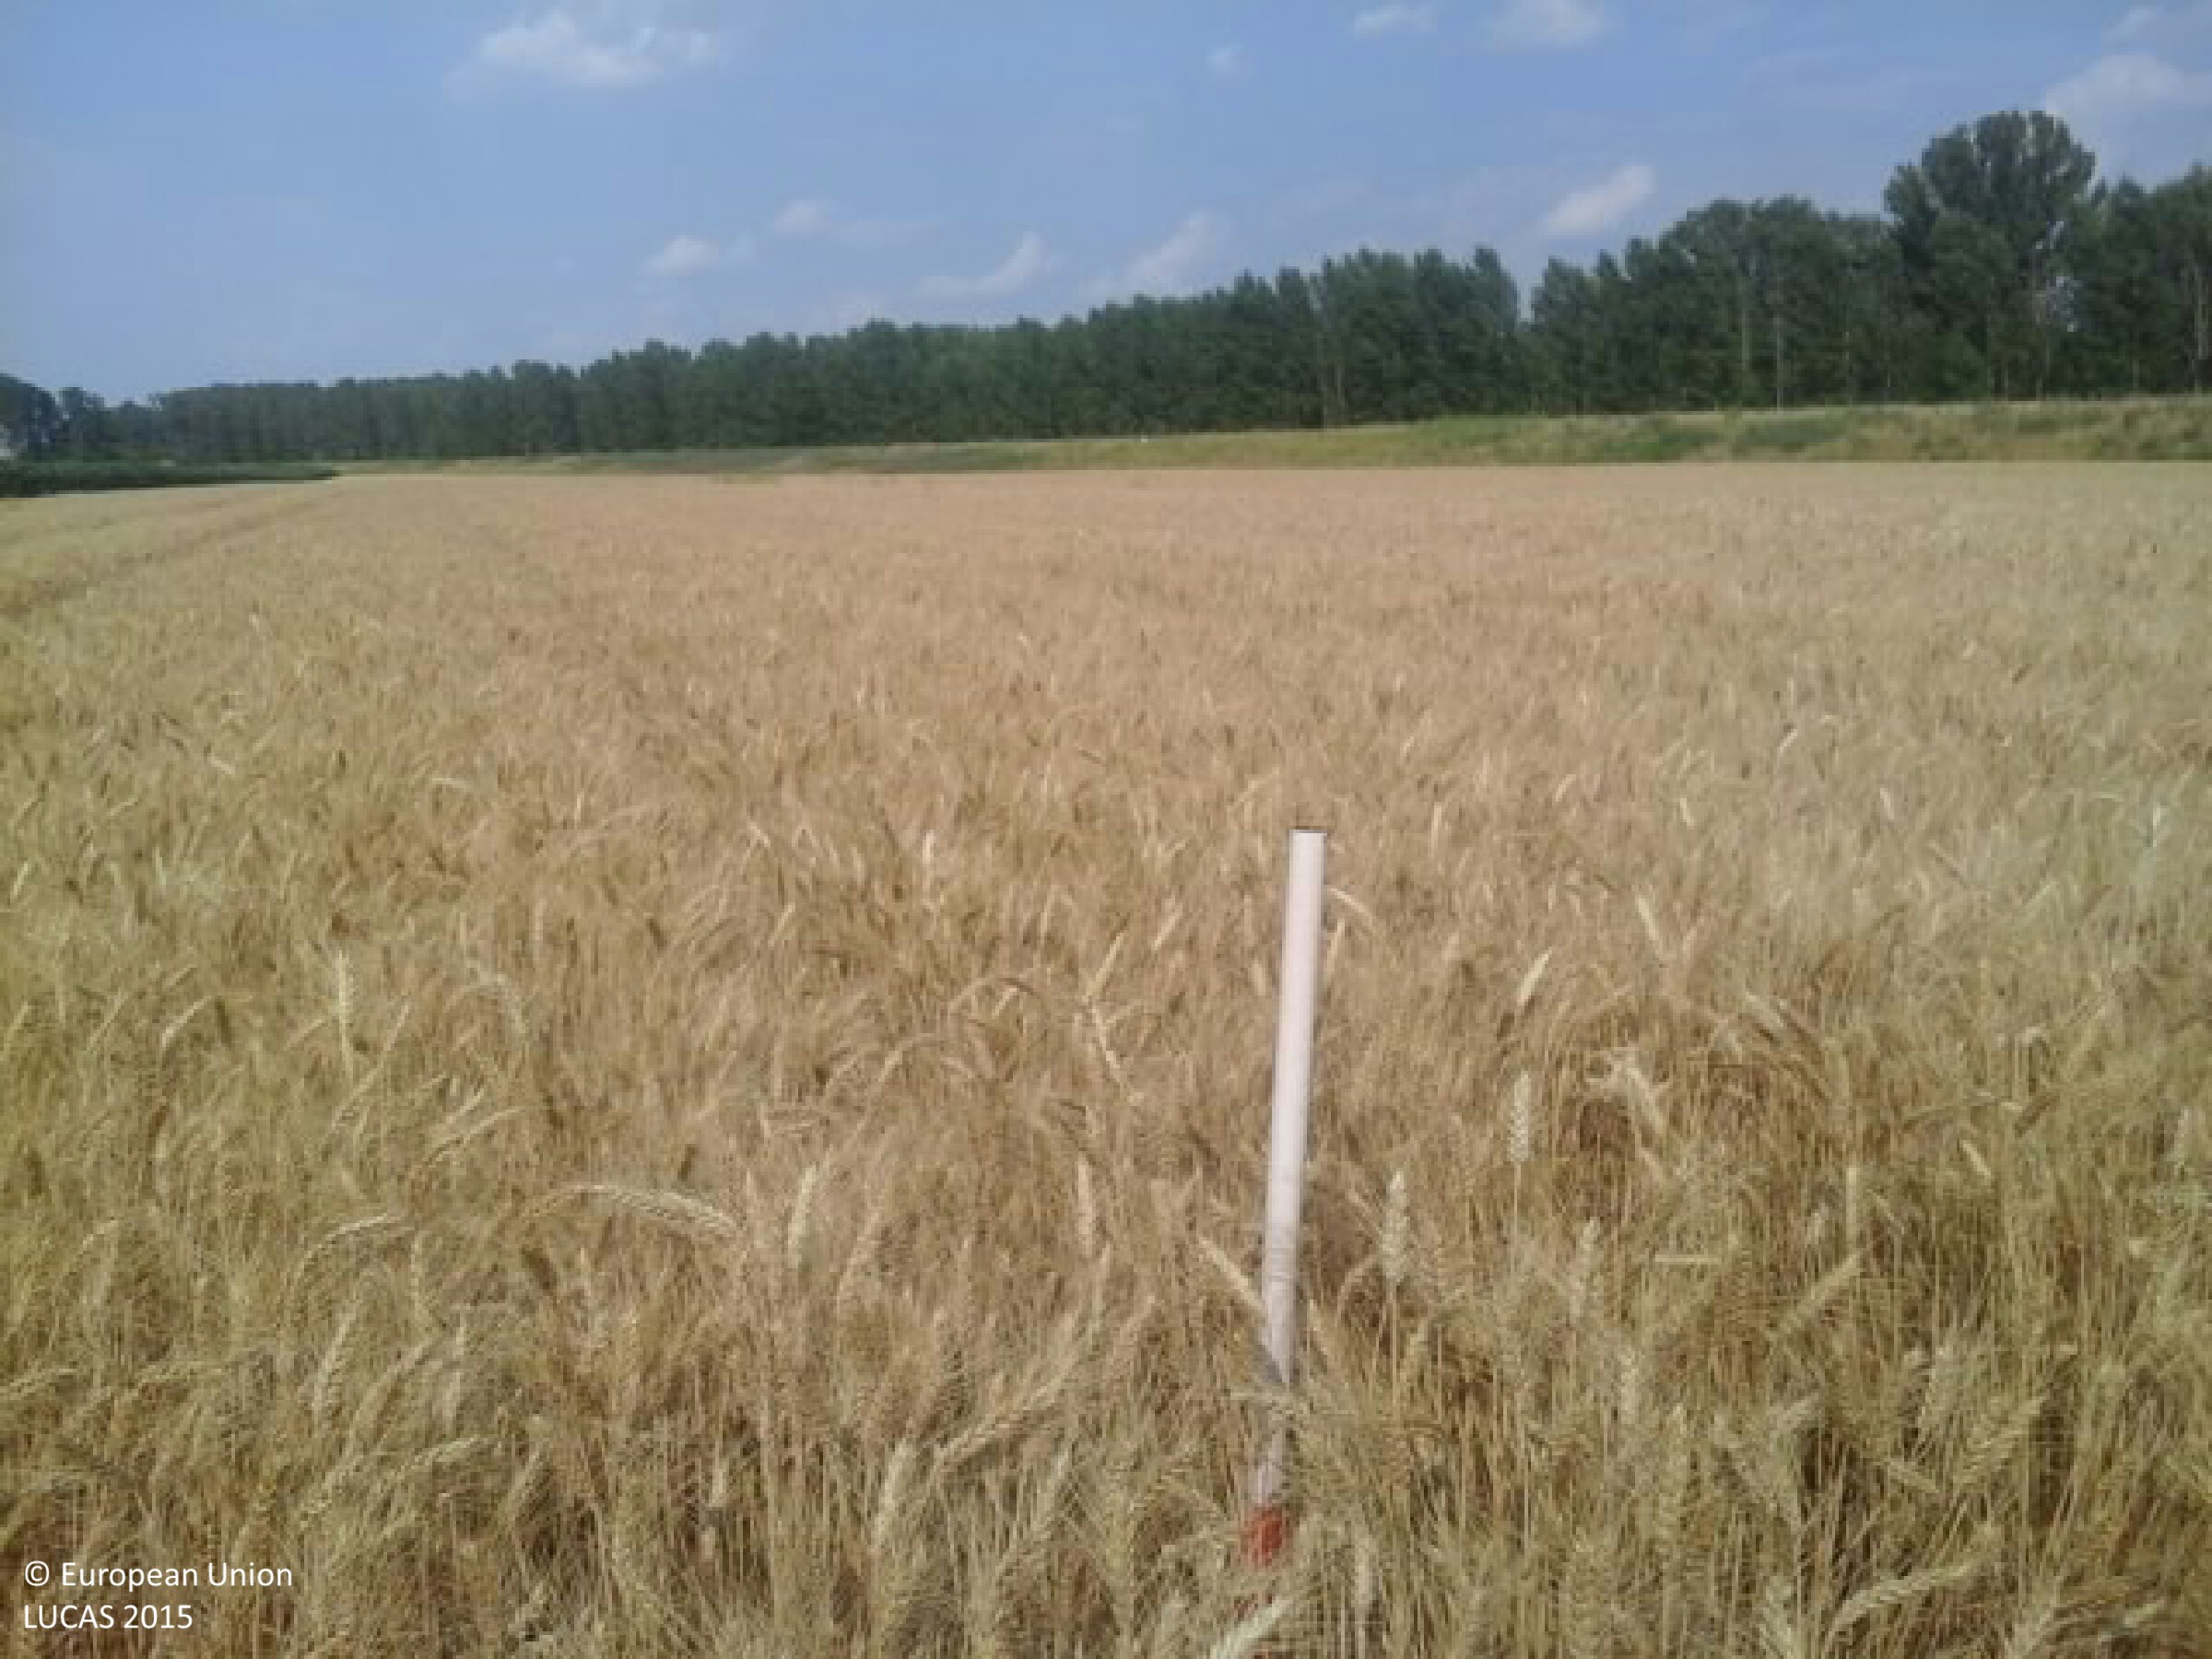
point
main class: Cropland
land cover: Common wheat
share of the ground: > 75 %
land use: Agriculture (excluding fallow land and kitchen gardens)
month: July
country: HU
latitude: 46.6624
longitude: 18.9664
